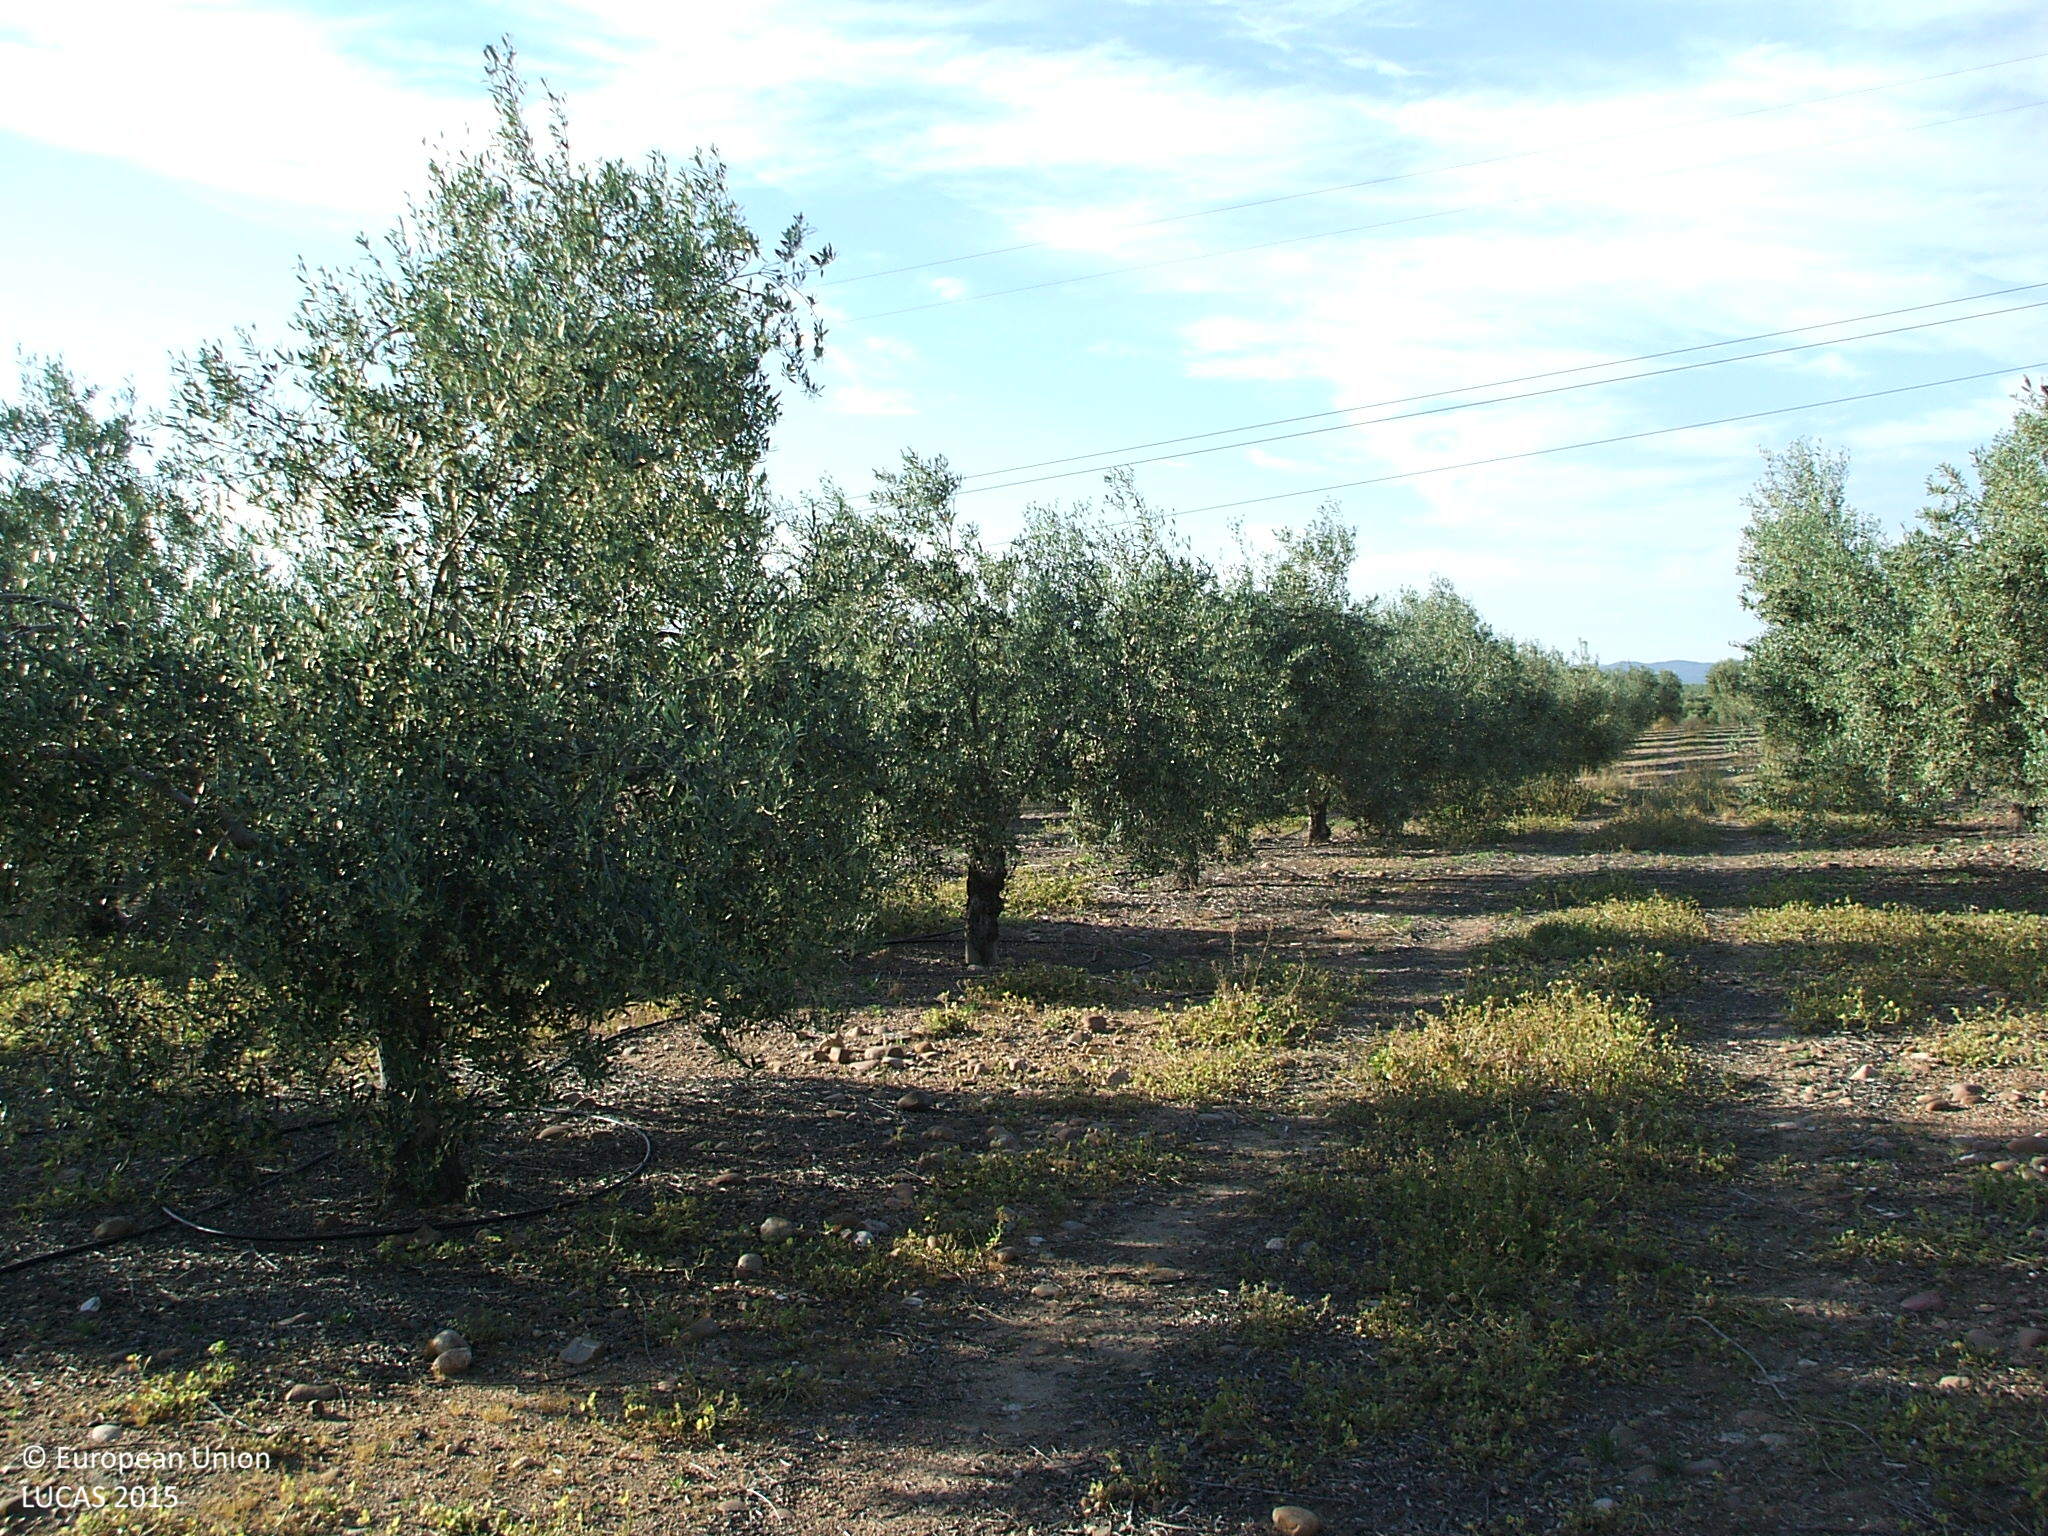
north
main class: Cropland
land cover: Olive groves
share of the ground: > 75 %
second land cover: Spontaneously vegetated surfaces
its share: > 75 %
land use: Agriculture (excluding fallow land and kitchen gardens)
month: April
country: ES
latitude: 37.6204
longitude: -5.4390
